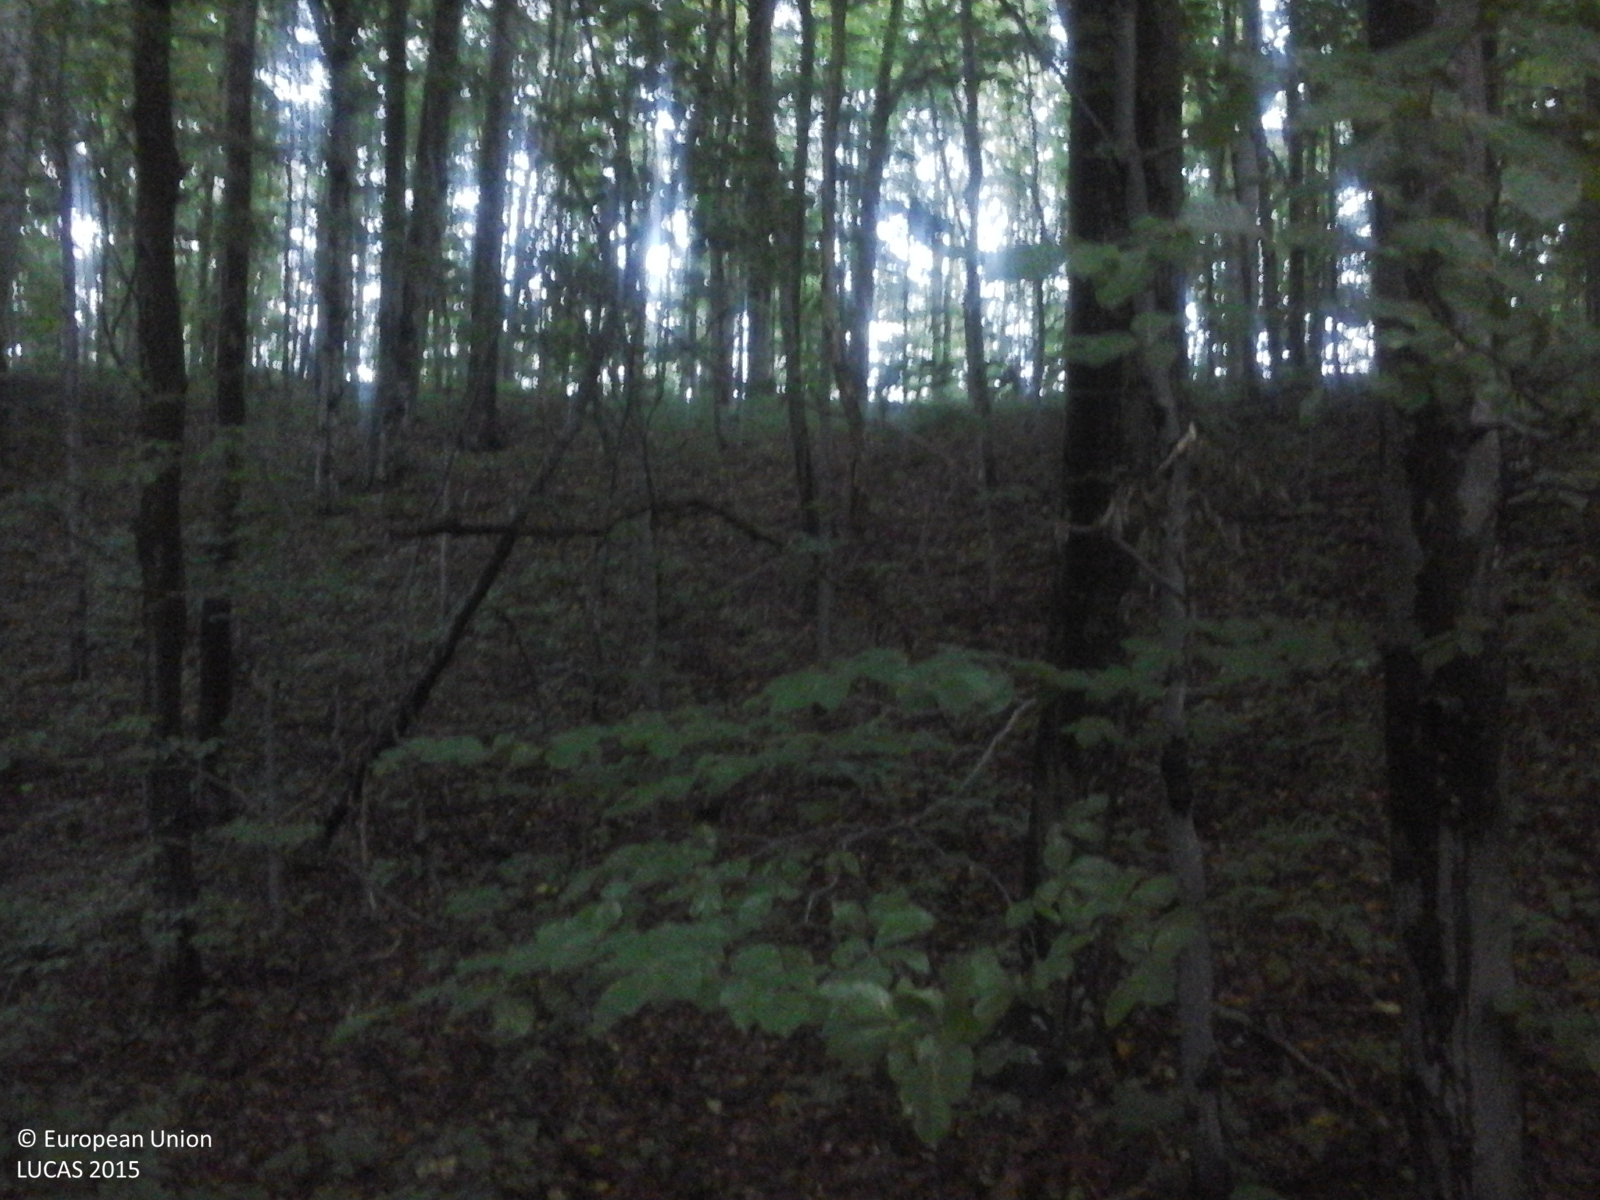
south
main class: Woodland
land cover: Broadleaved woodland
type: beech forest
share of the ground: > 75 %
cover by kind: broadleaved forest trees 100 %
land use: Forestry
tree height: > 5 m
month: August
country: RO
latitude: 44.7857
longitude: 21.7981
